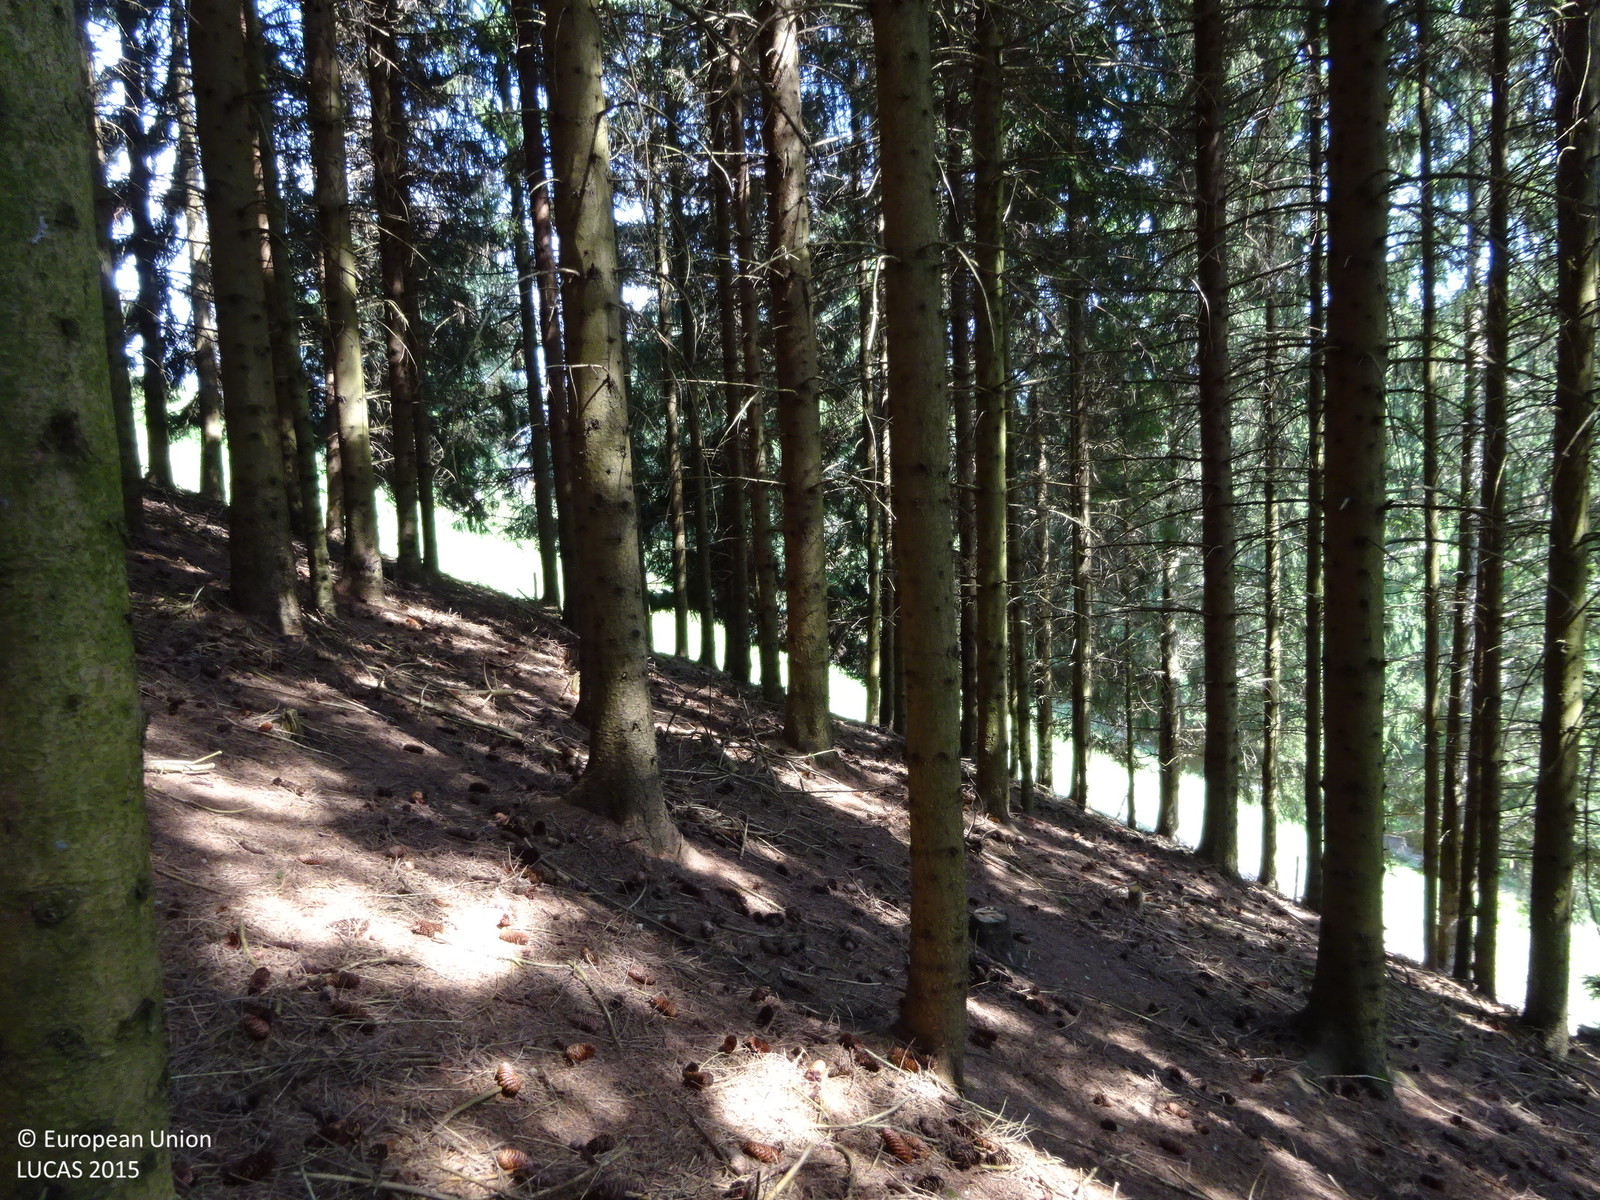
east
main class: Woodland
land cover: Spruce dominated coniferous woodland
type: alpine coniferous forest
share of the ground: > 75 %
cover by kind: coniferous forest trees 100 %
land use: Forestry
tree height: > 5 m
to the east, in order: Spruce dominated coniferous woodland; Fences; Grassland without tree/shrub cover; Spruce dominated mixed woodland; Grassland without tree/shrub cover; Fences; Grassland without tree/shrub cover; Fences; Grassland without tree/shrub cover; Electric lines; Single bushes/trees; Artificial constructions in urban areas
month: August
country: AT
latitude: 47.4589
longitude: 15.7717
